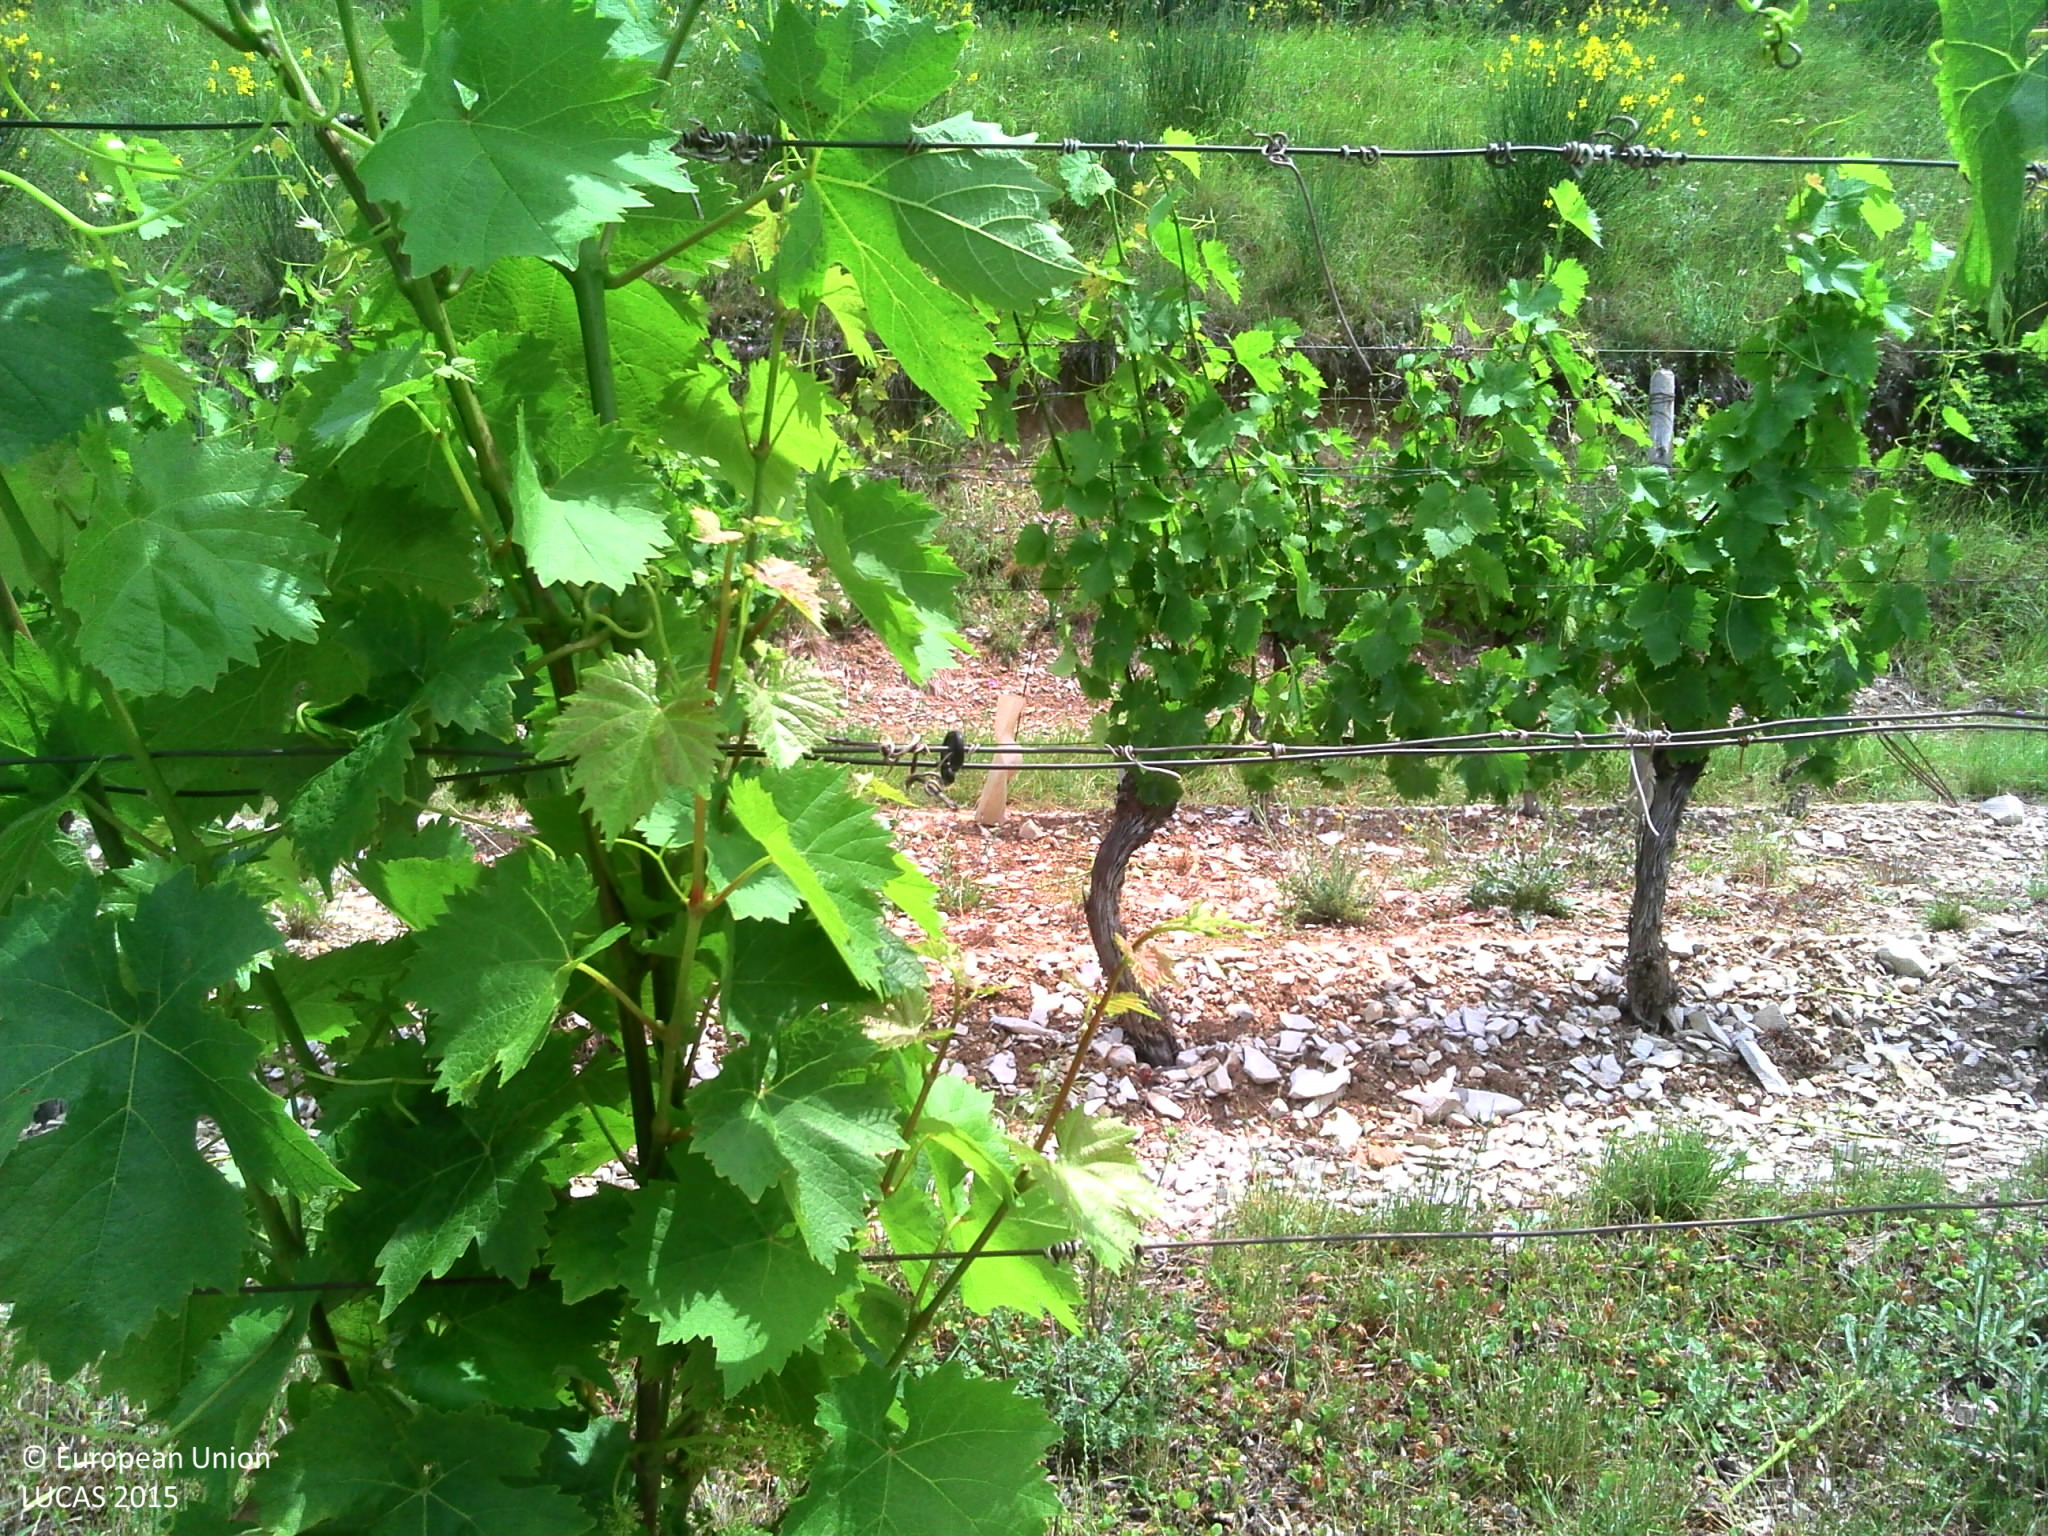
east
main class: Cropland
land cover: Vineyards
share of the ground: > 75 %
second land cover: Other bare soil
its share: > 75 %
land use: Agriculture (excluding fallow land and kitchen gardens)
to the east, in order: Vineyards; Other bare soil; Grass margins; Shrubland with sparse tree cover; Tracks; Pine dominated mixed woodland
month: June
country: FR
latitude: 44.6899
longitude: 5.1738
